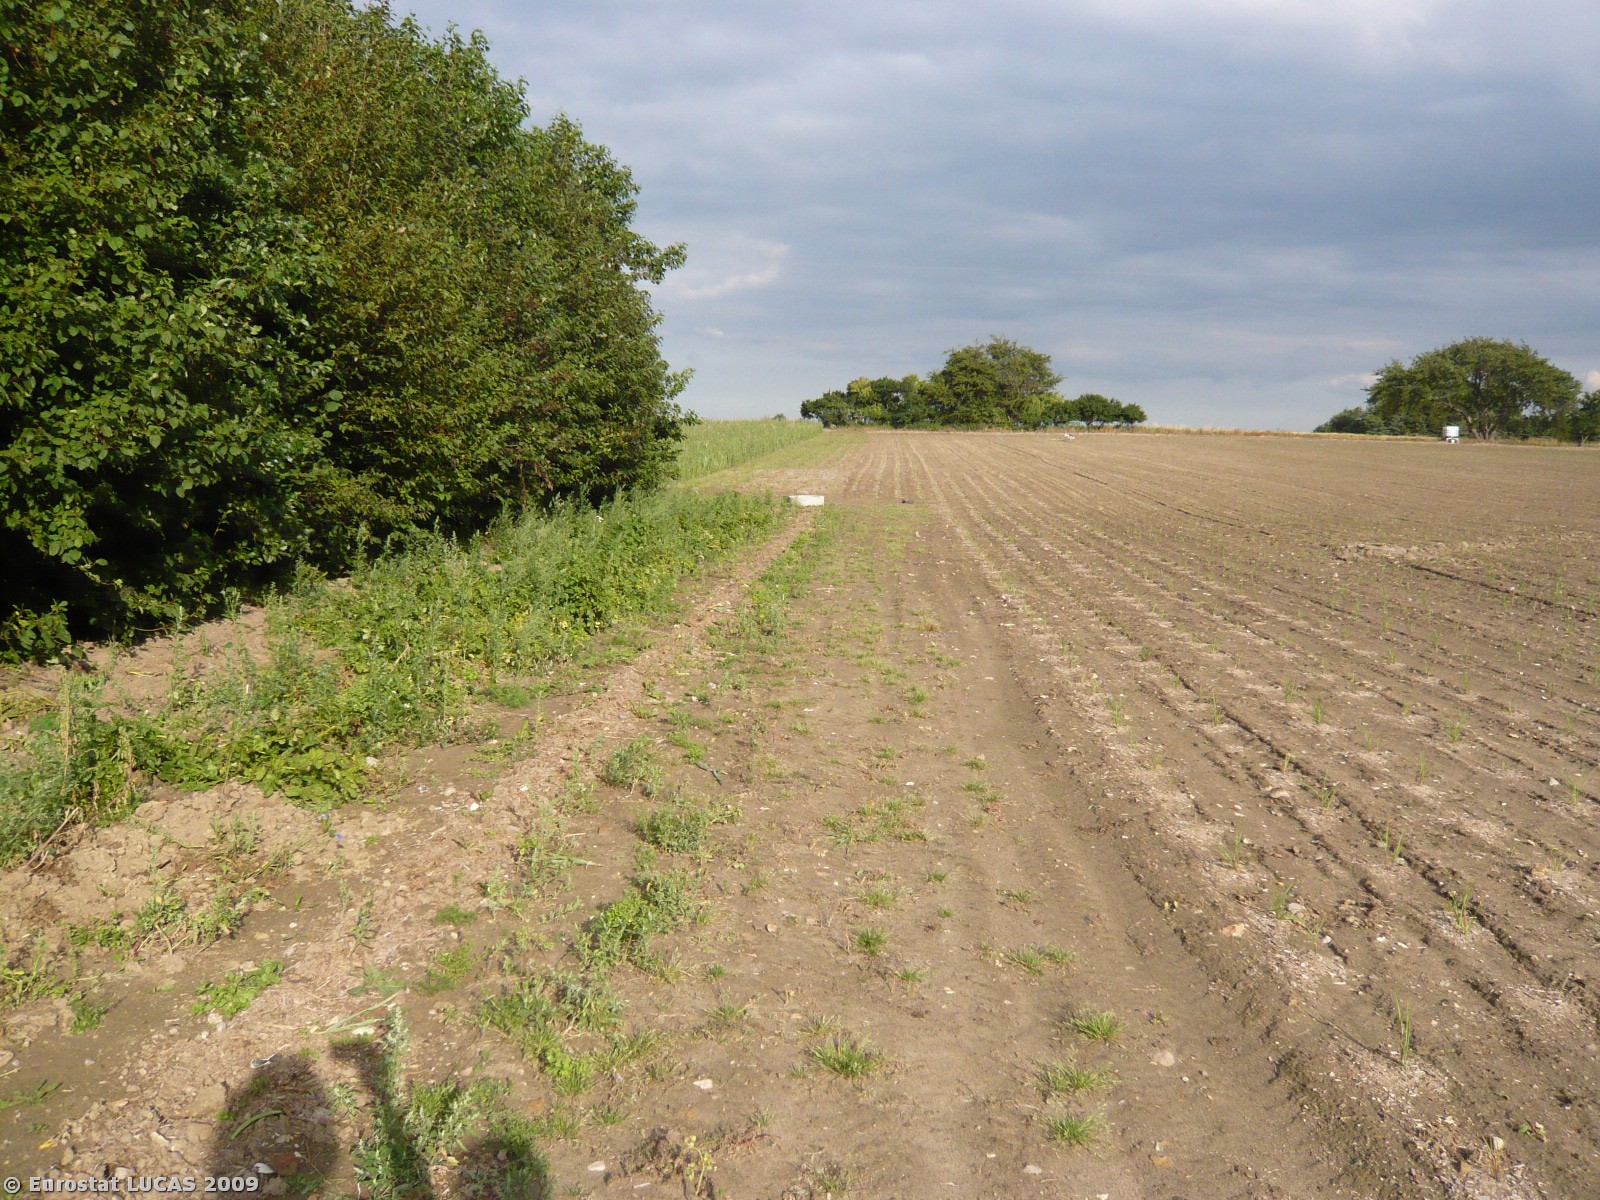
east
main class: Cropland
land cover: Barley
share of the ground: < 10 %
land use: Agriculture (excluding fallow land and kitchen gardens)
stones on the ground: 10 - 25 %
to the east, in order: Barley; Electric lines; Broadleaved woodland; Barley; Broadleaved woodland; Common wheat
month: May
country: DK
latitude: 55.2974
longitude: 11.5580
